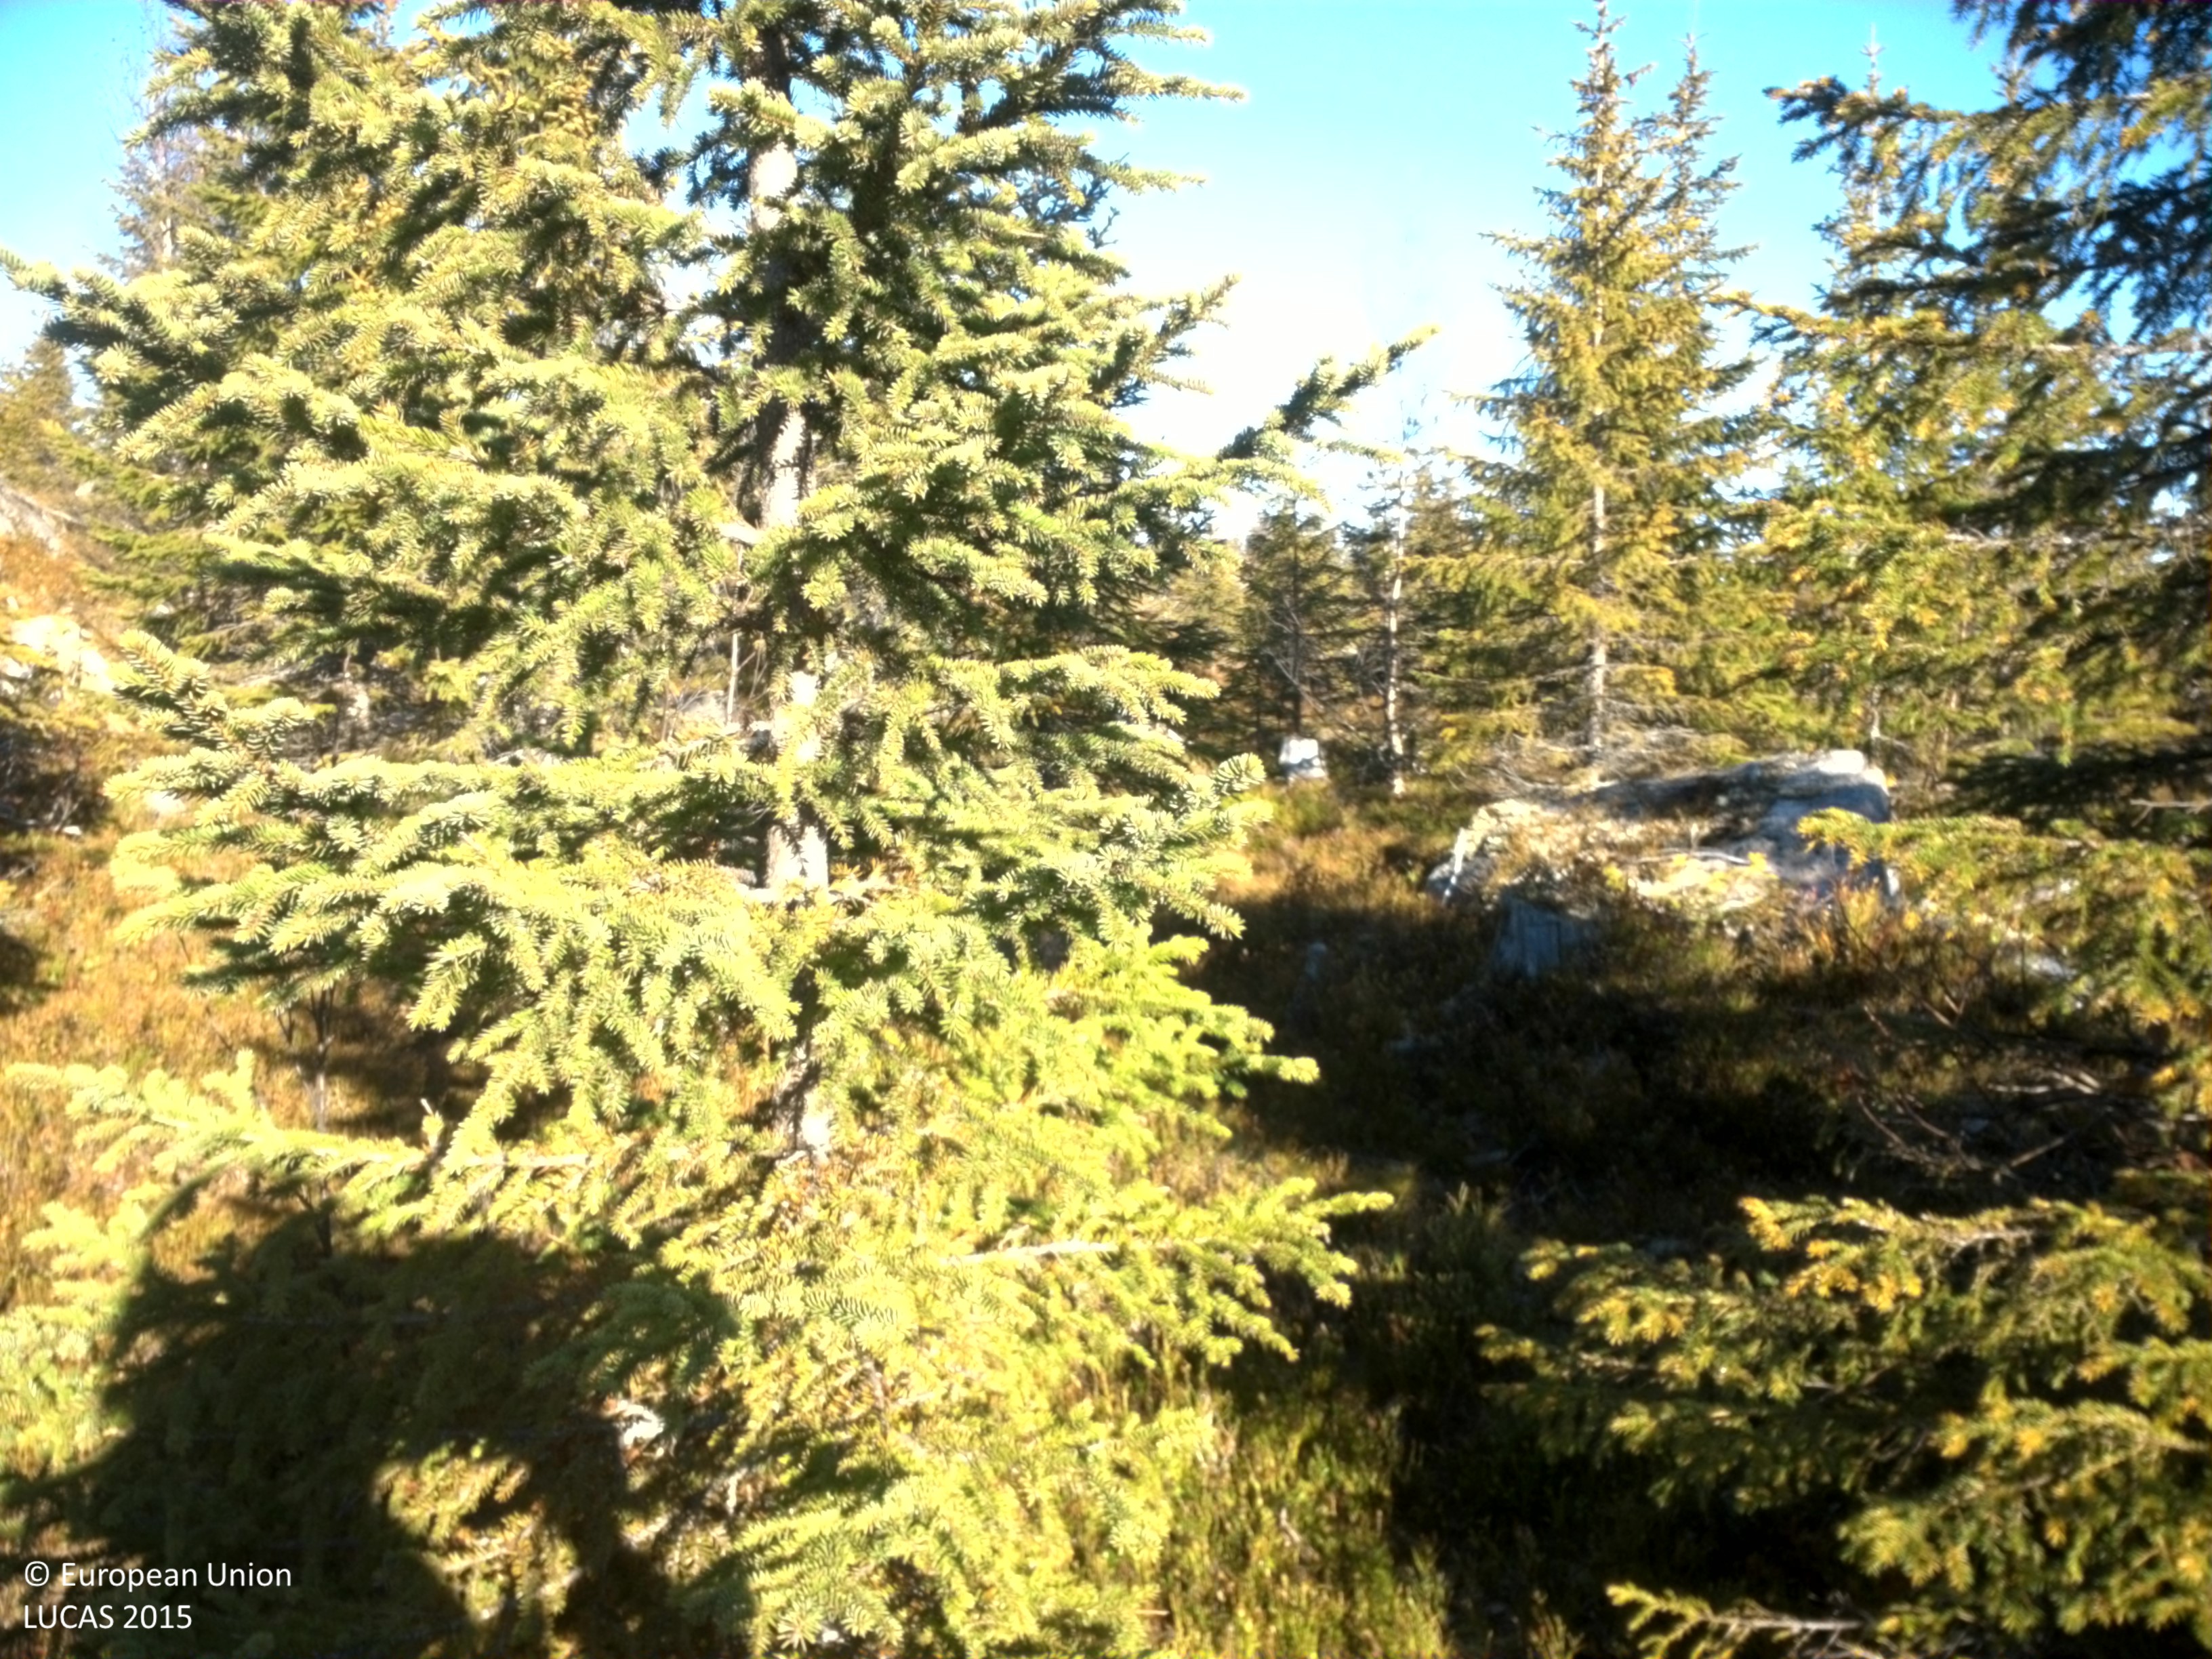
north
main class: Woodland
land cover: Spruce dominated coniferous woodland
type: boreal forest
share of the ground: 10 - 25 %
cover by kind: shrubs 65 %, coniferous forest trees 15 %, herbaceous plants 10 %, lichens and mosses 10 %
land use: Forestry
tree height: < 5 m
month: October
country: SE
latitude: 64.8645
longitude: 16.9068
